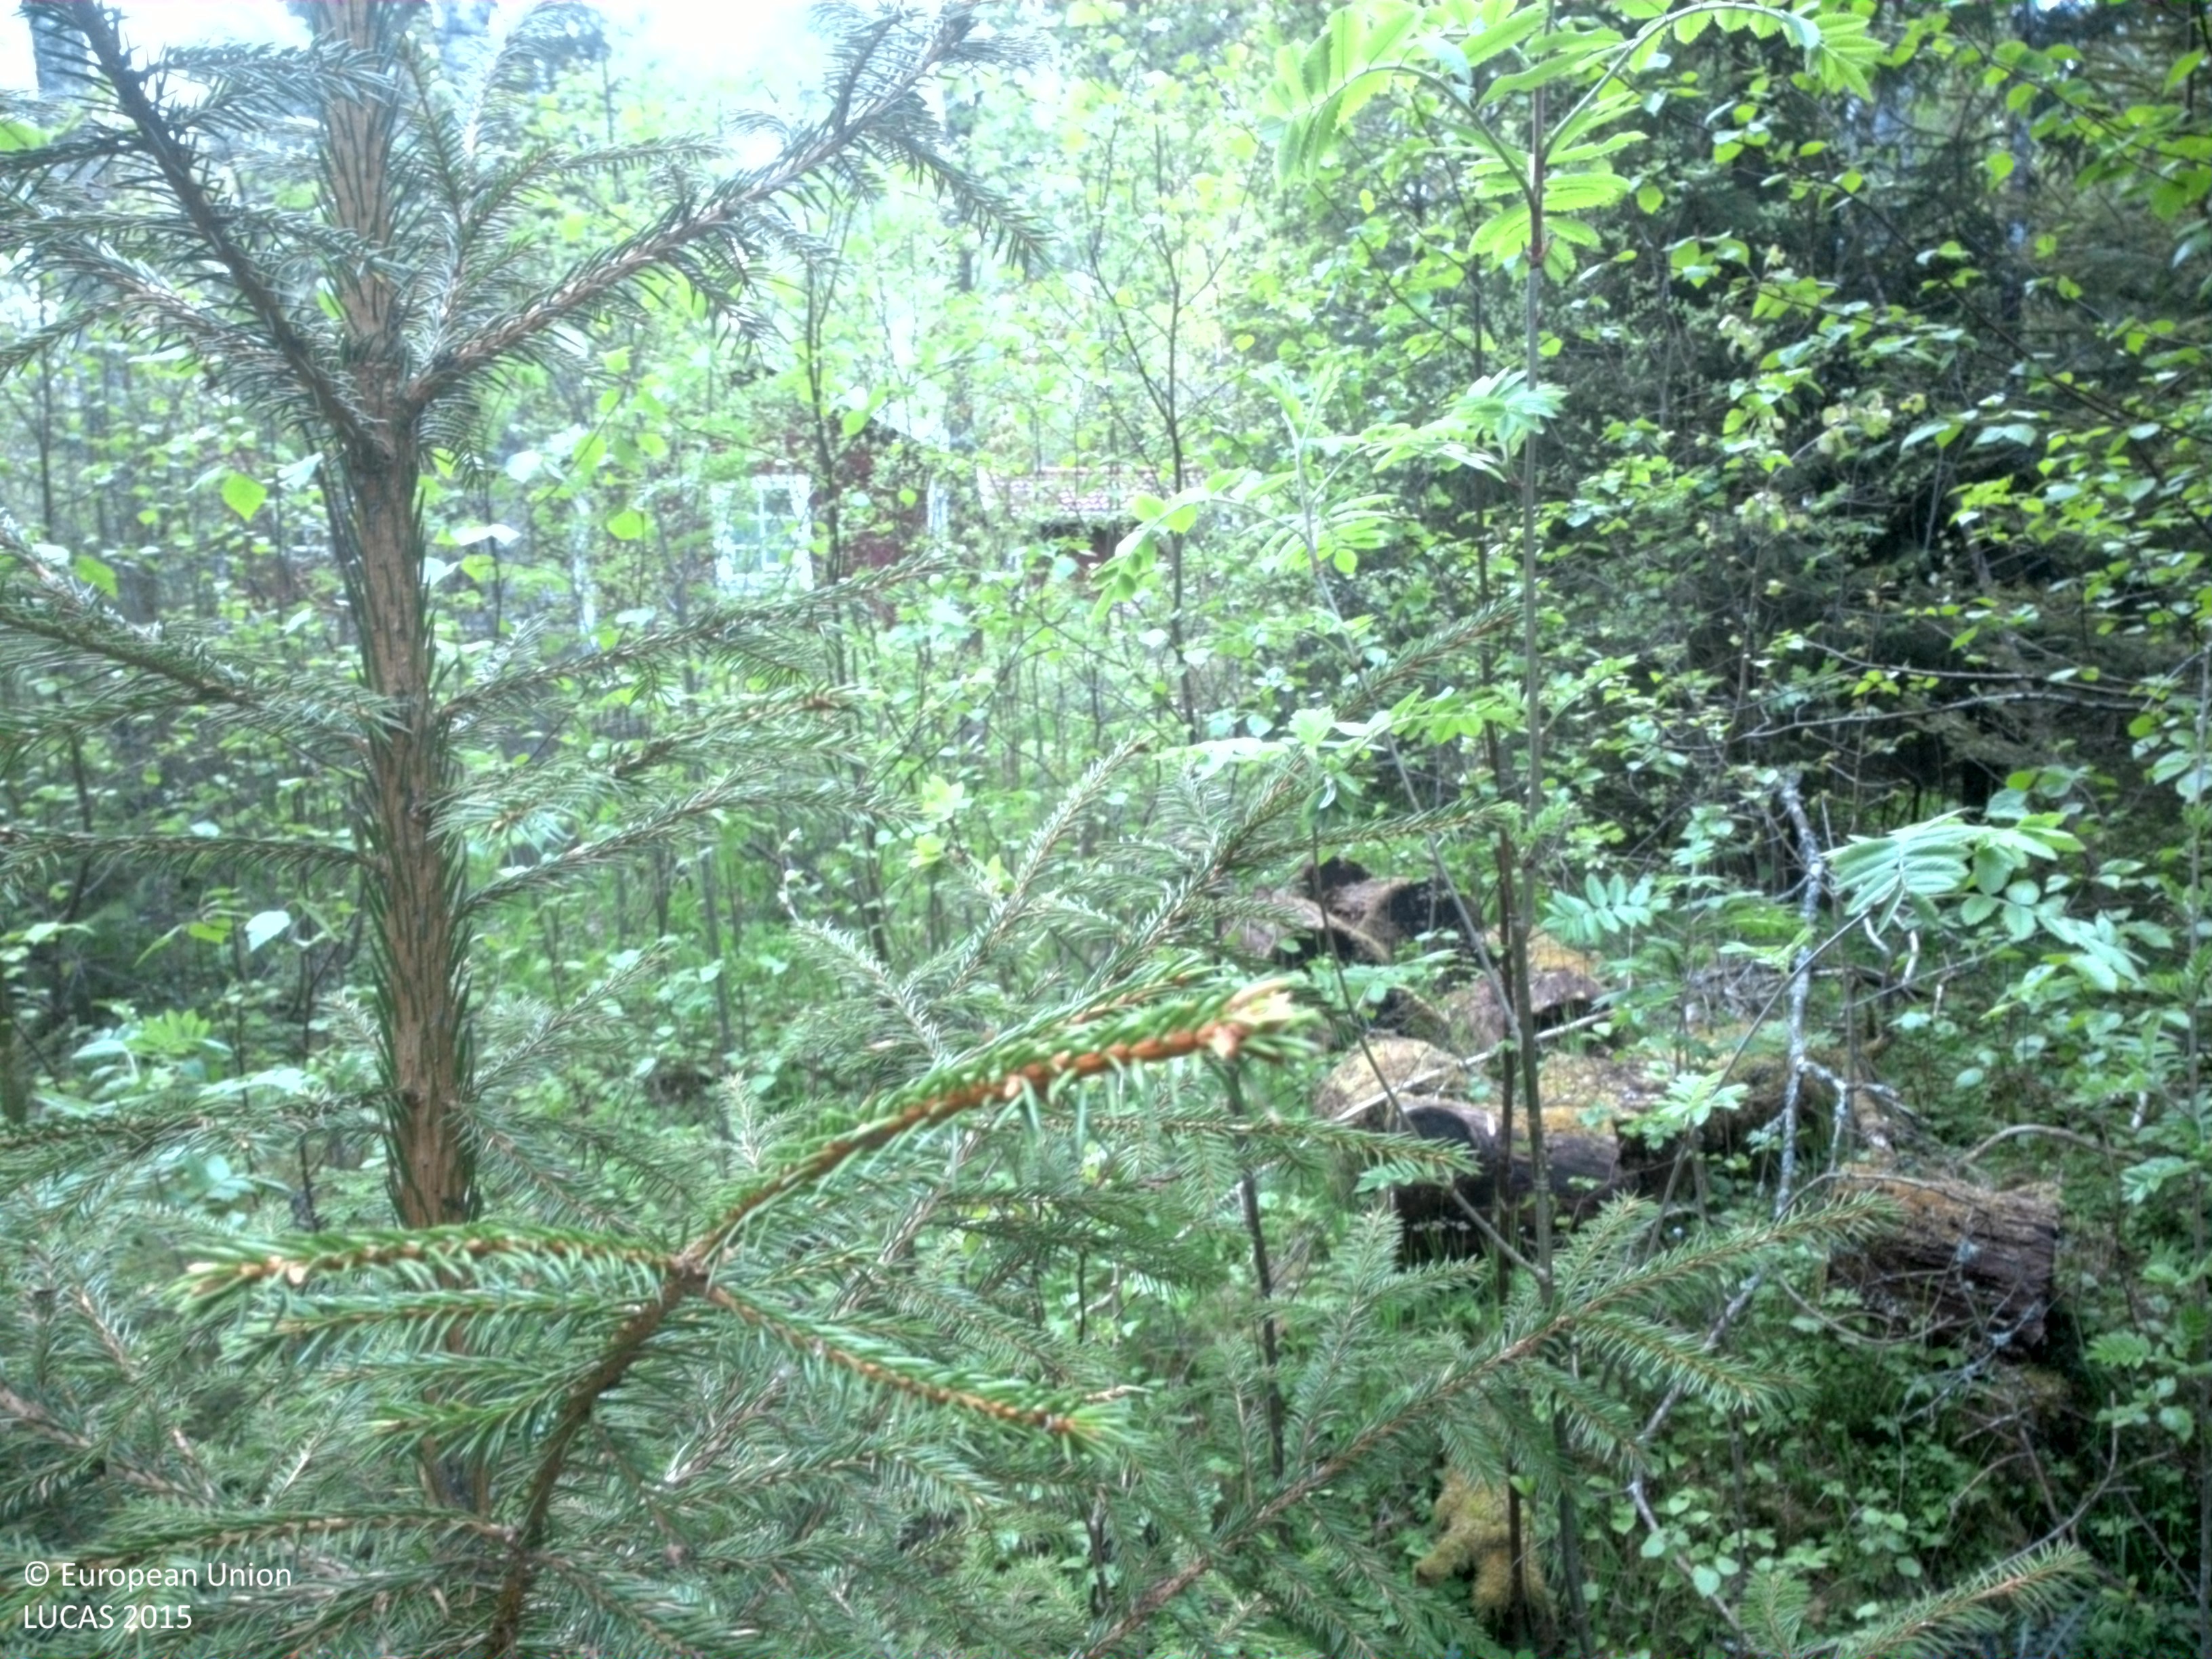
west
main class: Woodland
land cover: Broadleaved woodland
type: boreal forest
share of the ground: 50 - 75 %
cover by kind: broadleaved forest trees 65 %, shrubs 15 %, coniferous forest trees 10 %, herbaceous plants 10 %
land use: Forestry
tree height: > 5 m
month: May
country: SE
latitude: 56.6397
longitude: 15.2322
